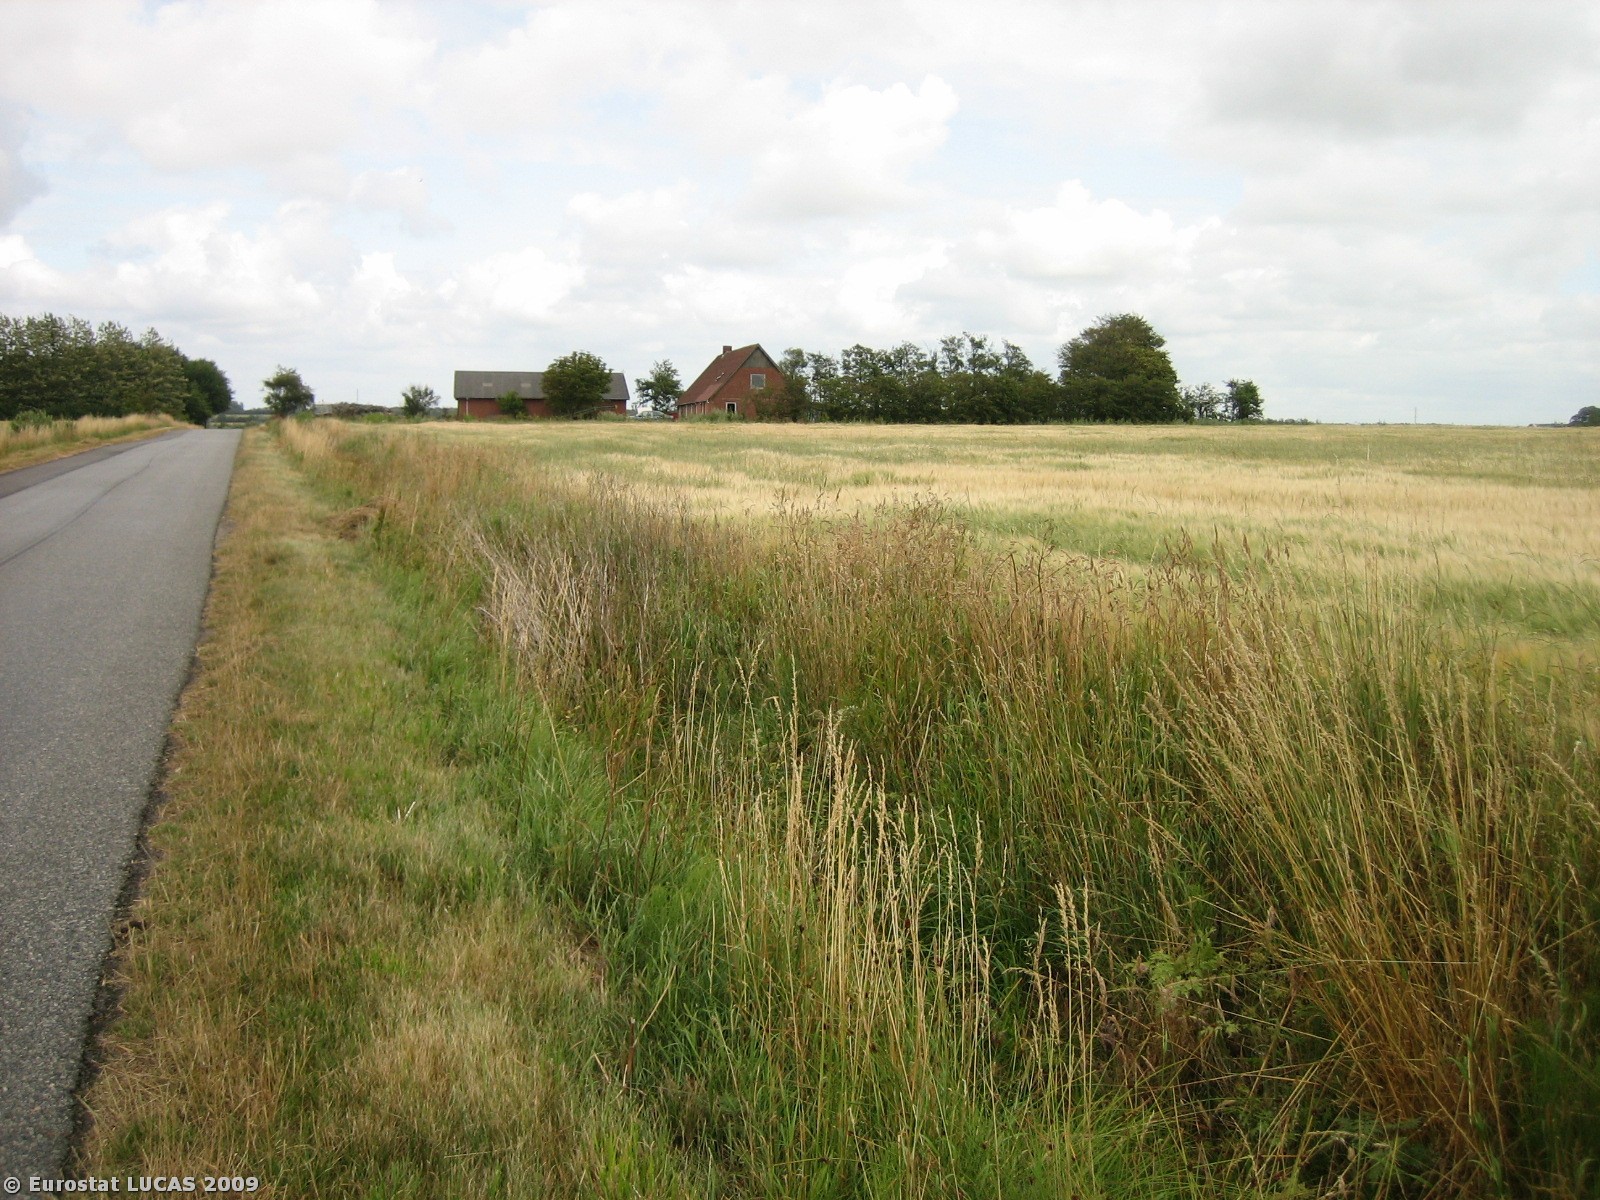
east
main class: Cropland
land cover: Barley
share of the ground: > 75 %
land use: Agriculture (excluding fallow land and kitchen gardens)
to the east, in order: Barley; Broadleaved woodland; Barley; Broadleaved woodland; Barley
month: July
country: DK
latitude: 55.8559
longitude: 8.5477
